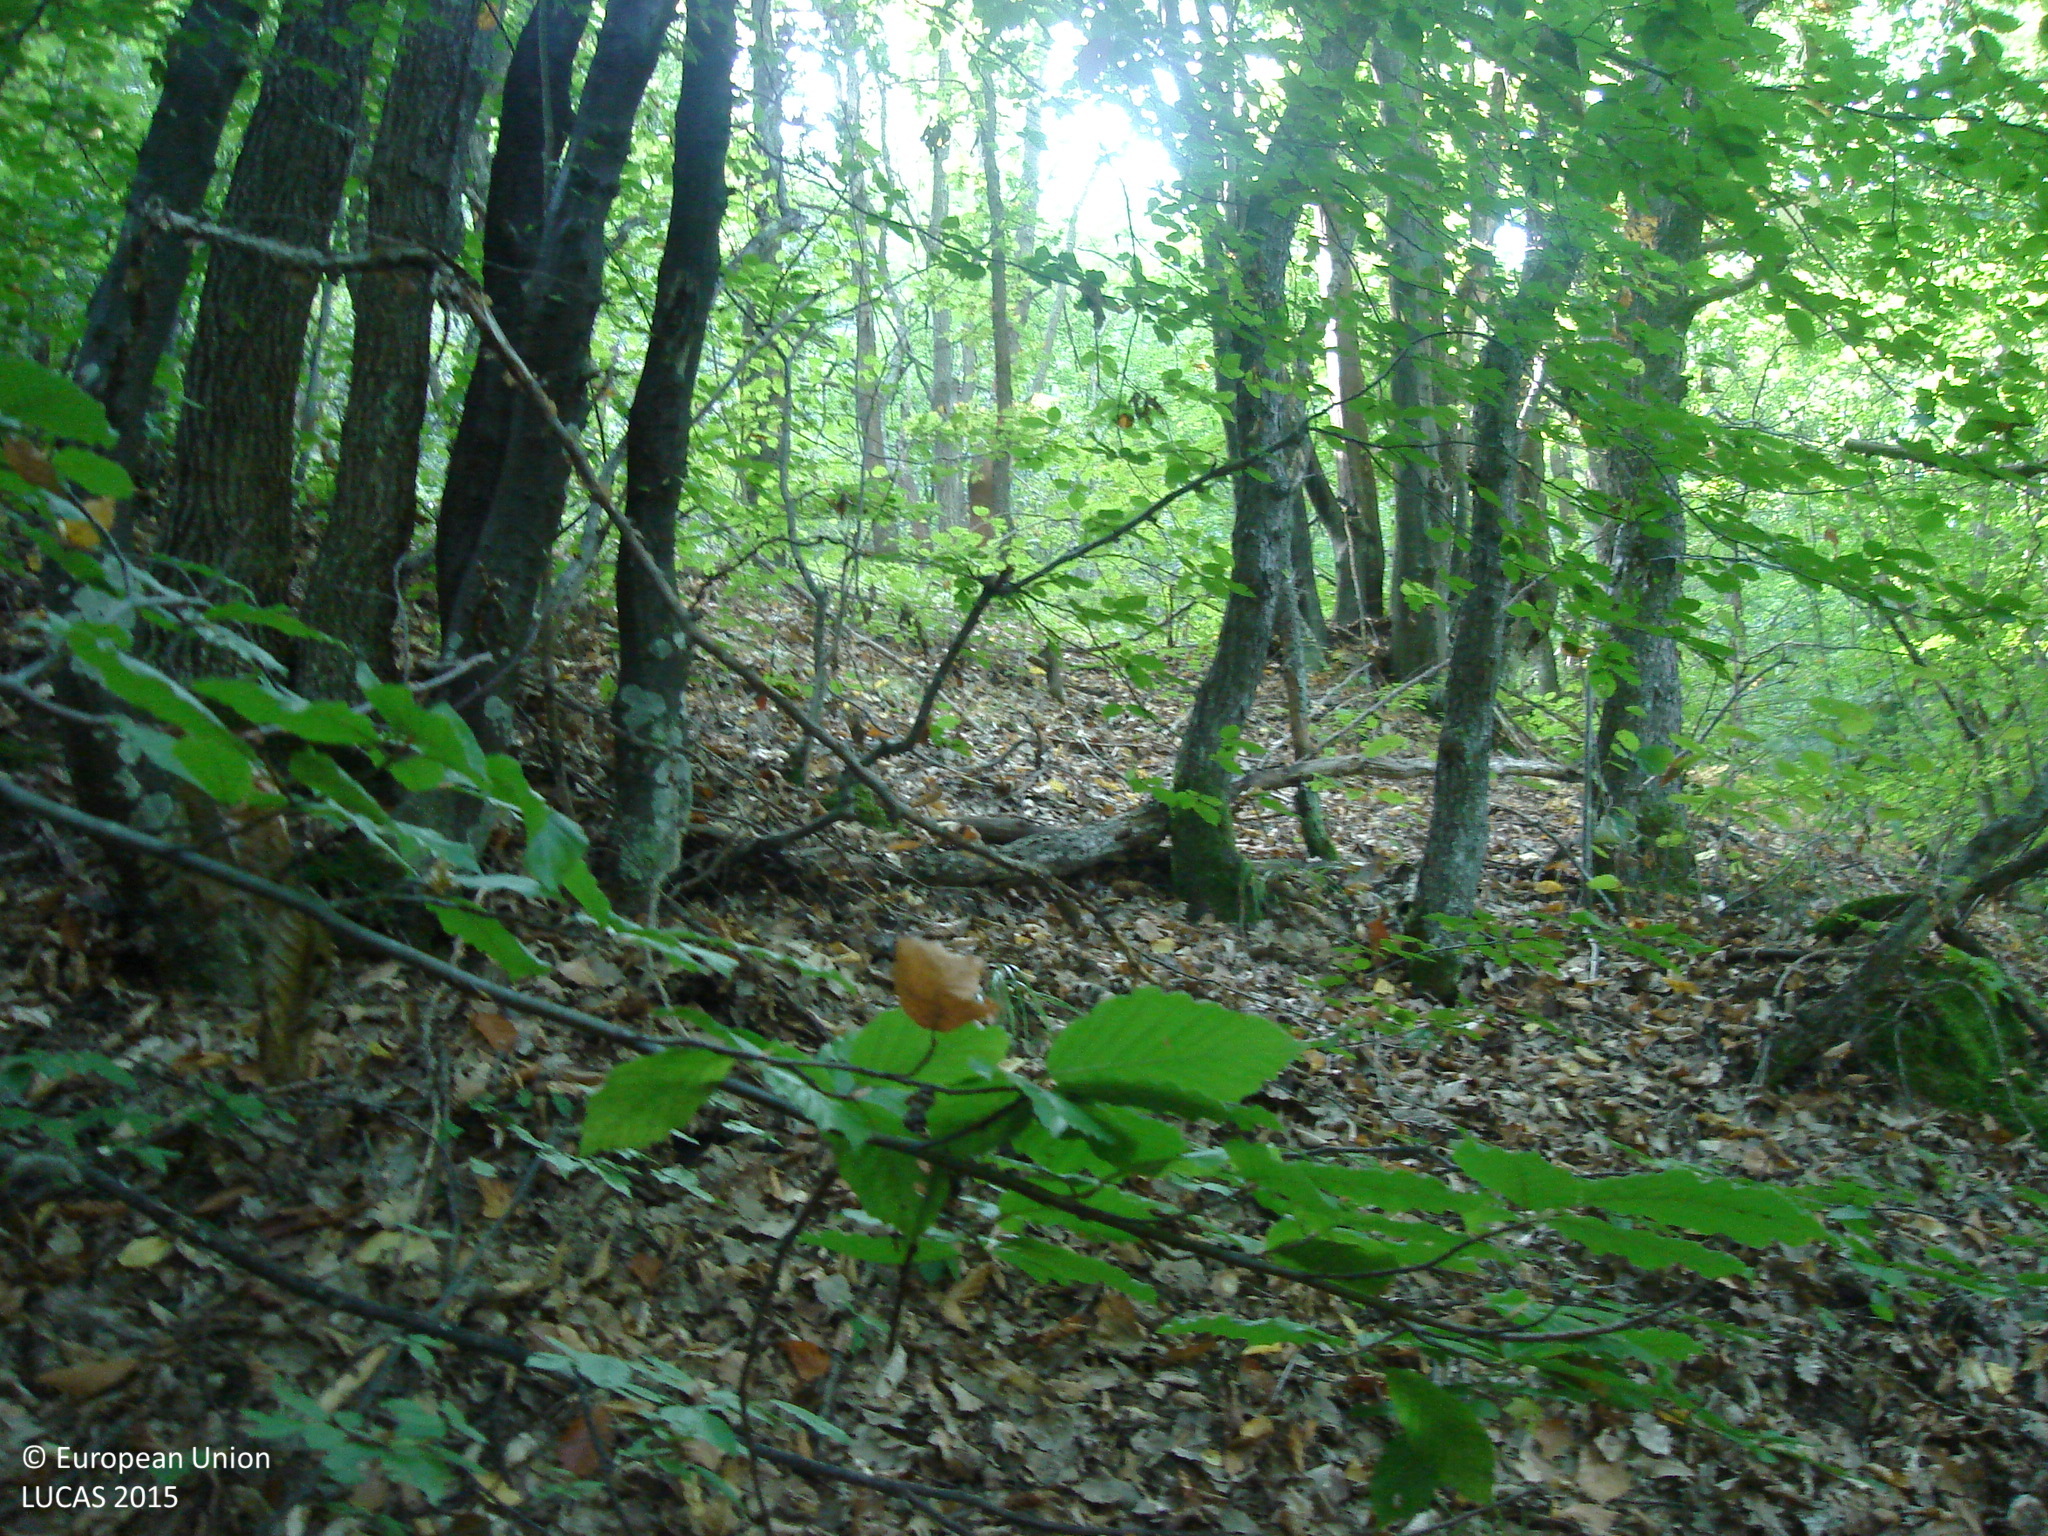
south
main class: Woodland
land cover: Broadleaved woodland
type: thermophilous deciduous forest
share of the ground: > 75 %
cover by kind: broadleaved forest trees 100 %
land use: Forestry
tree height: > 5 m
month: September
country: BG
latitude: 42.8973
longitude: 23.2241
